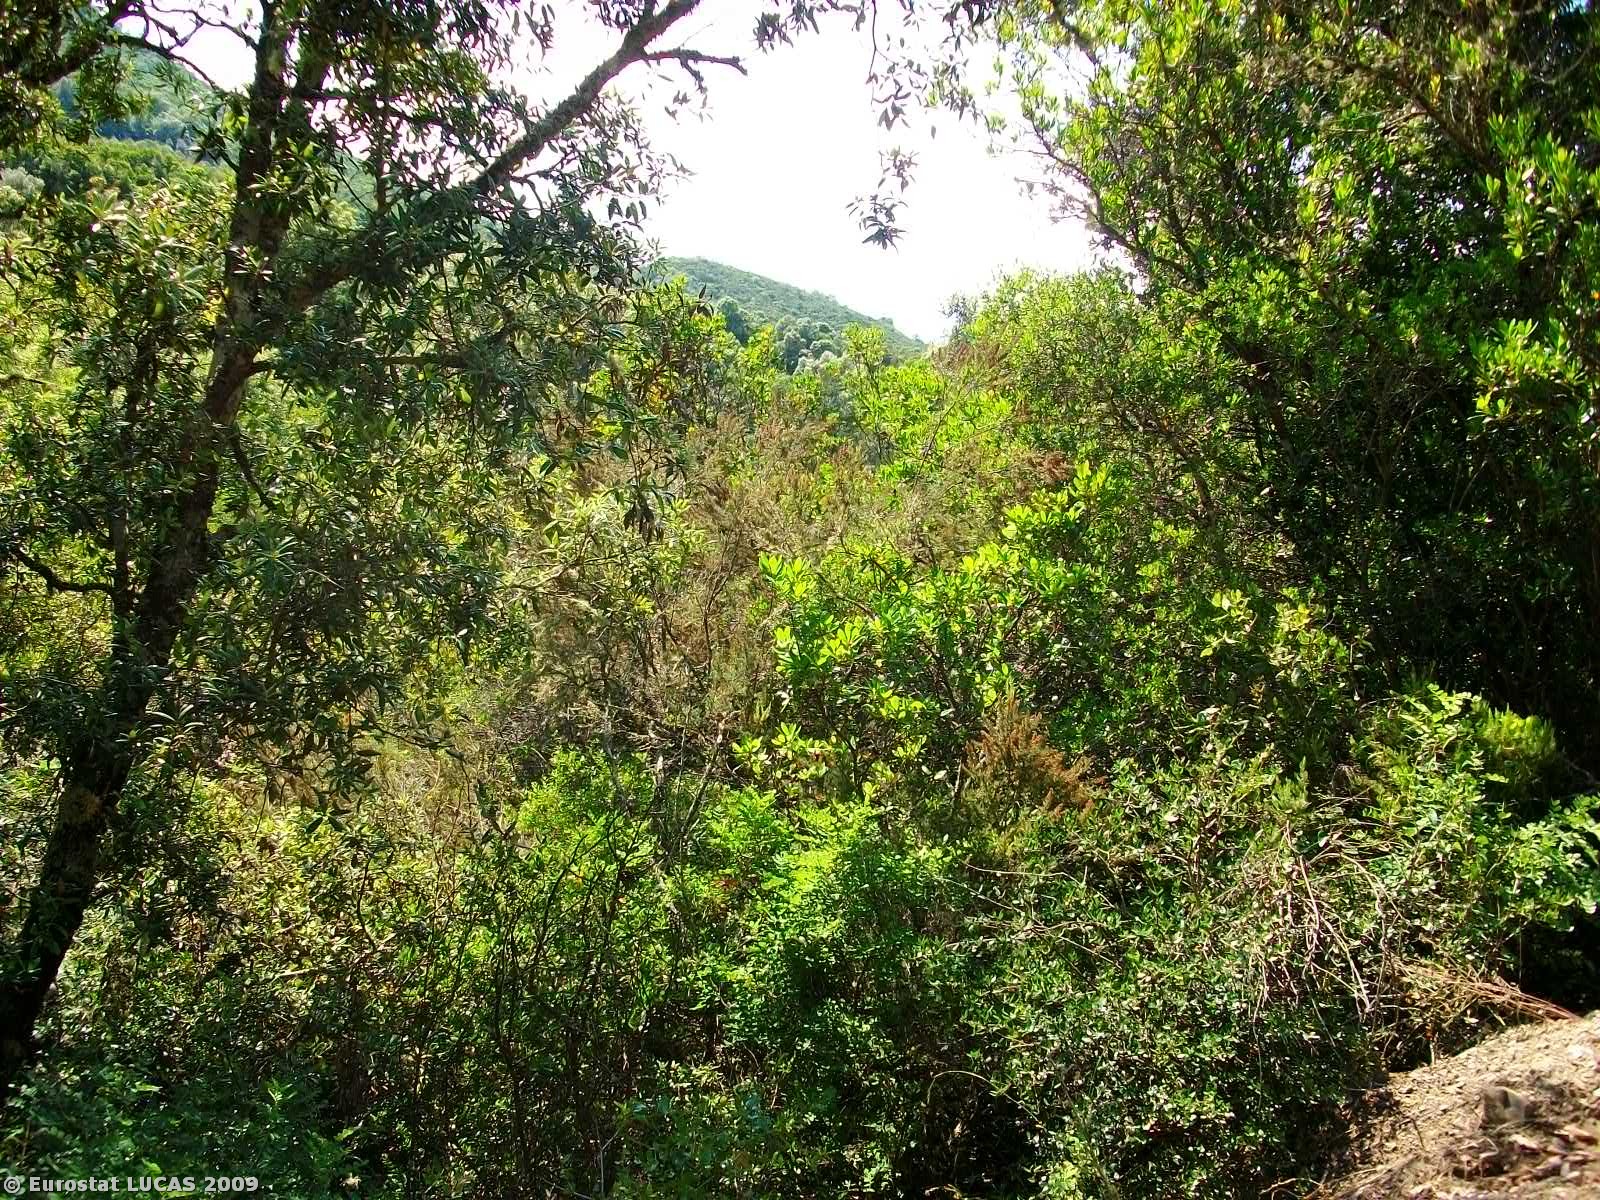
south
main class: Woodland
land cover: Mixed woodland
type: broadleaved evergreen forest
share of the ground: > 75 %
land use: Forestry
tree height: > 5 m
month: June
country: GR
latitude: 38.7882
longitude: 21.4733
